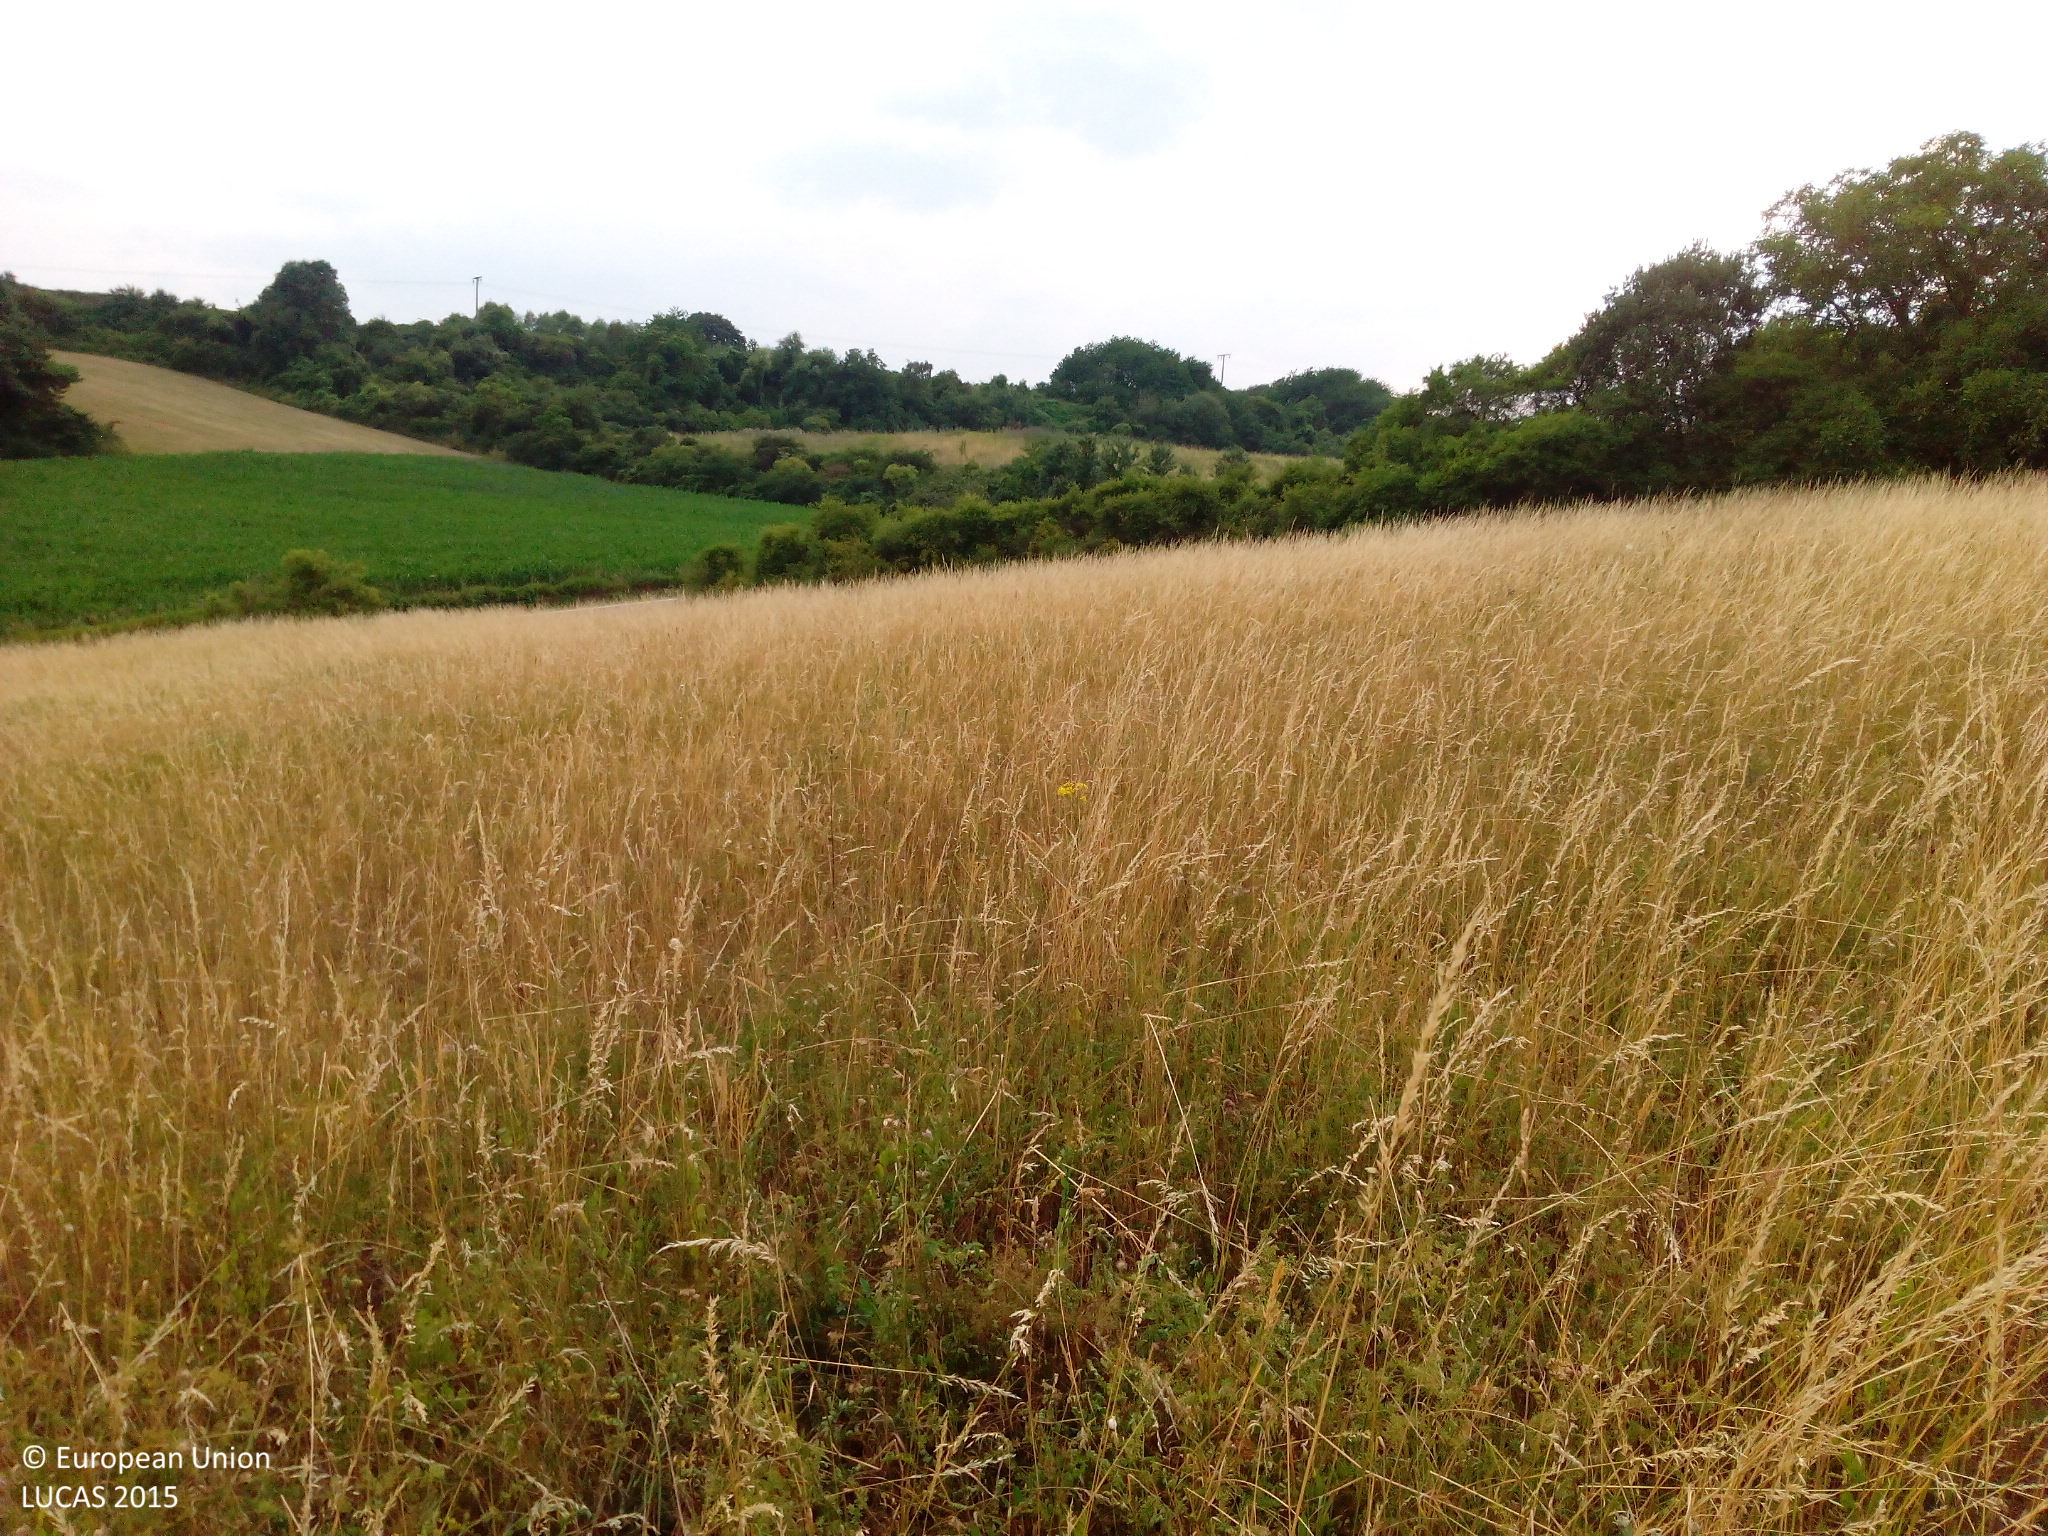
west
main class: Grassland
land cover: Grassland without tree/shrub cover
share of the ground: > 75 %
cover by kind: herbaceous plants 100 %
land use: Agriculture (excluding fallow land and kitchen gardens)
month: July
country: DE
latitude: 49.5188
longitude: 9.9586
